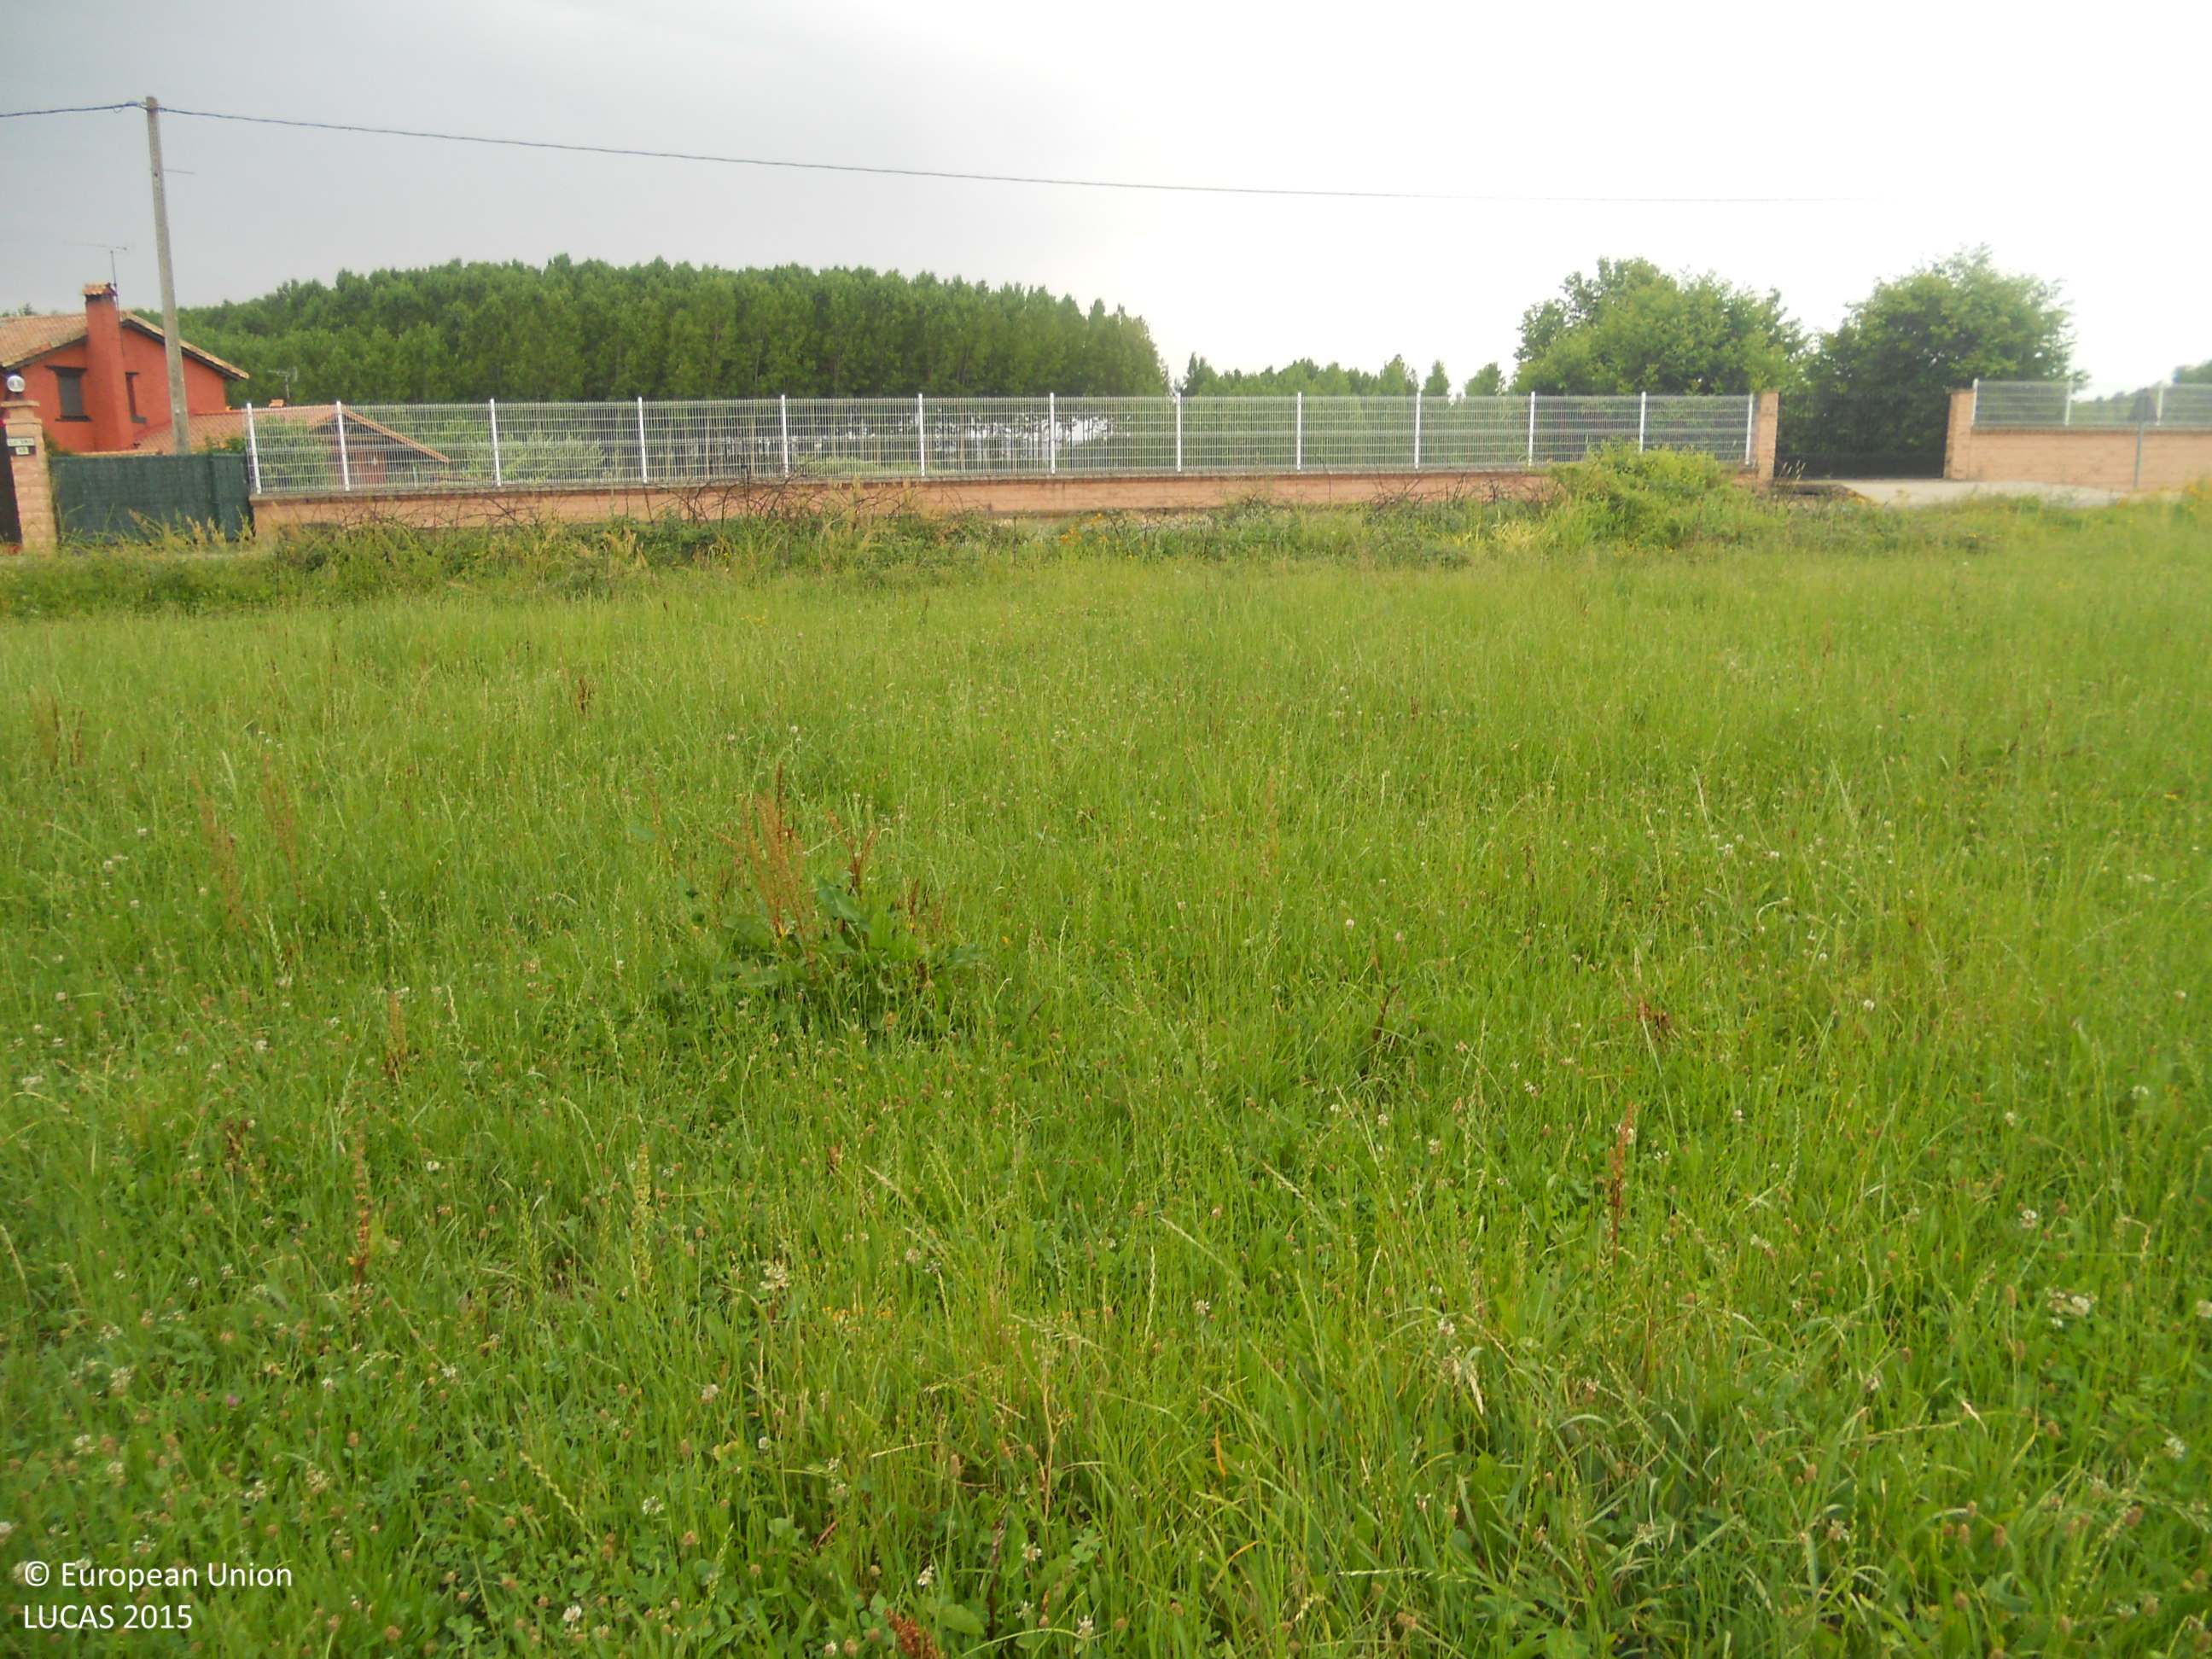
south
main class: Grassland
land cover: Grassland without tree/shrub cover
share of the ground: > 75 %
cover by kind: herbaceous plants 100 %
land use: Agriculture (excluding fallow land and kitchen gardens)
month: July
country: ES
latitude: 42.6637
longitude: -5.3811
